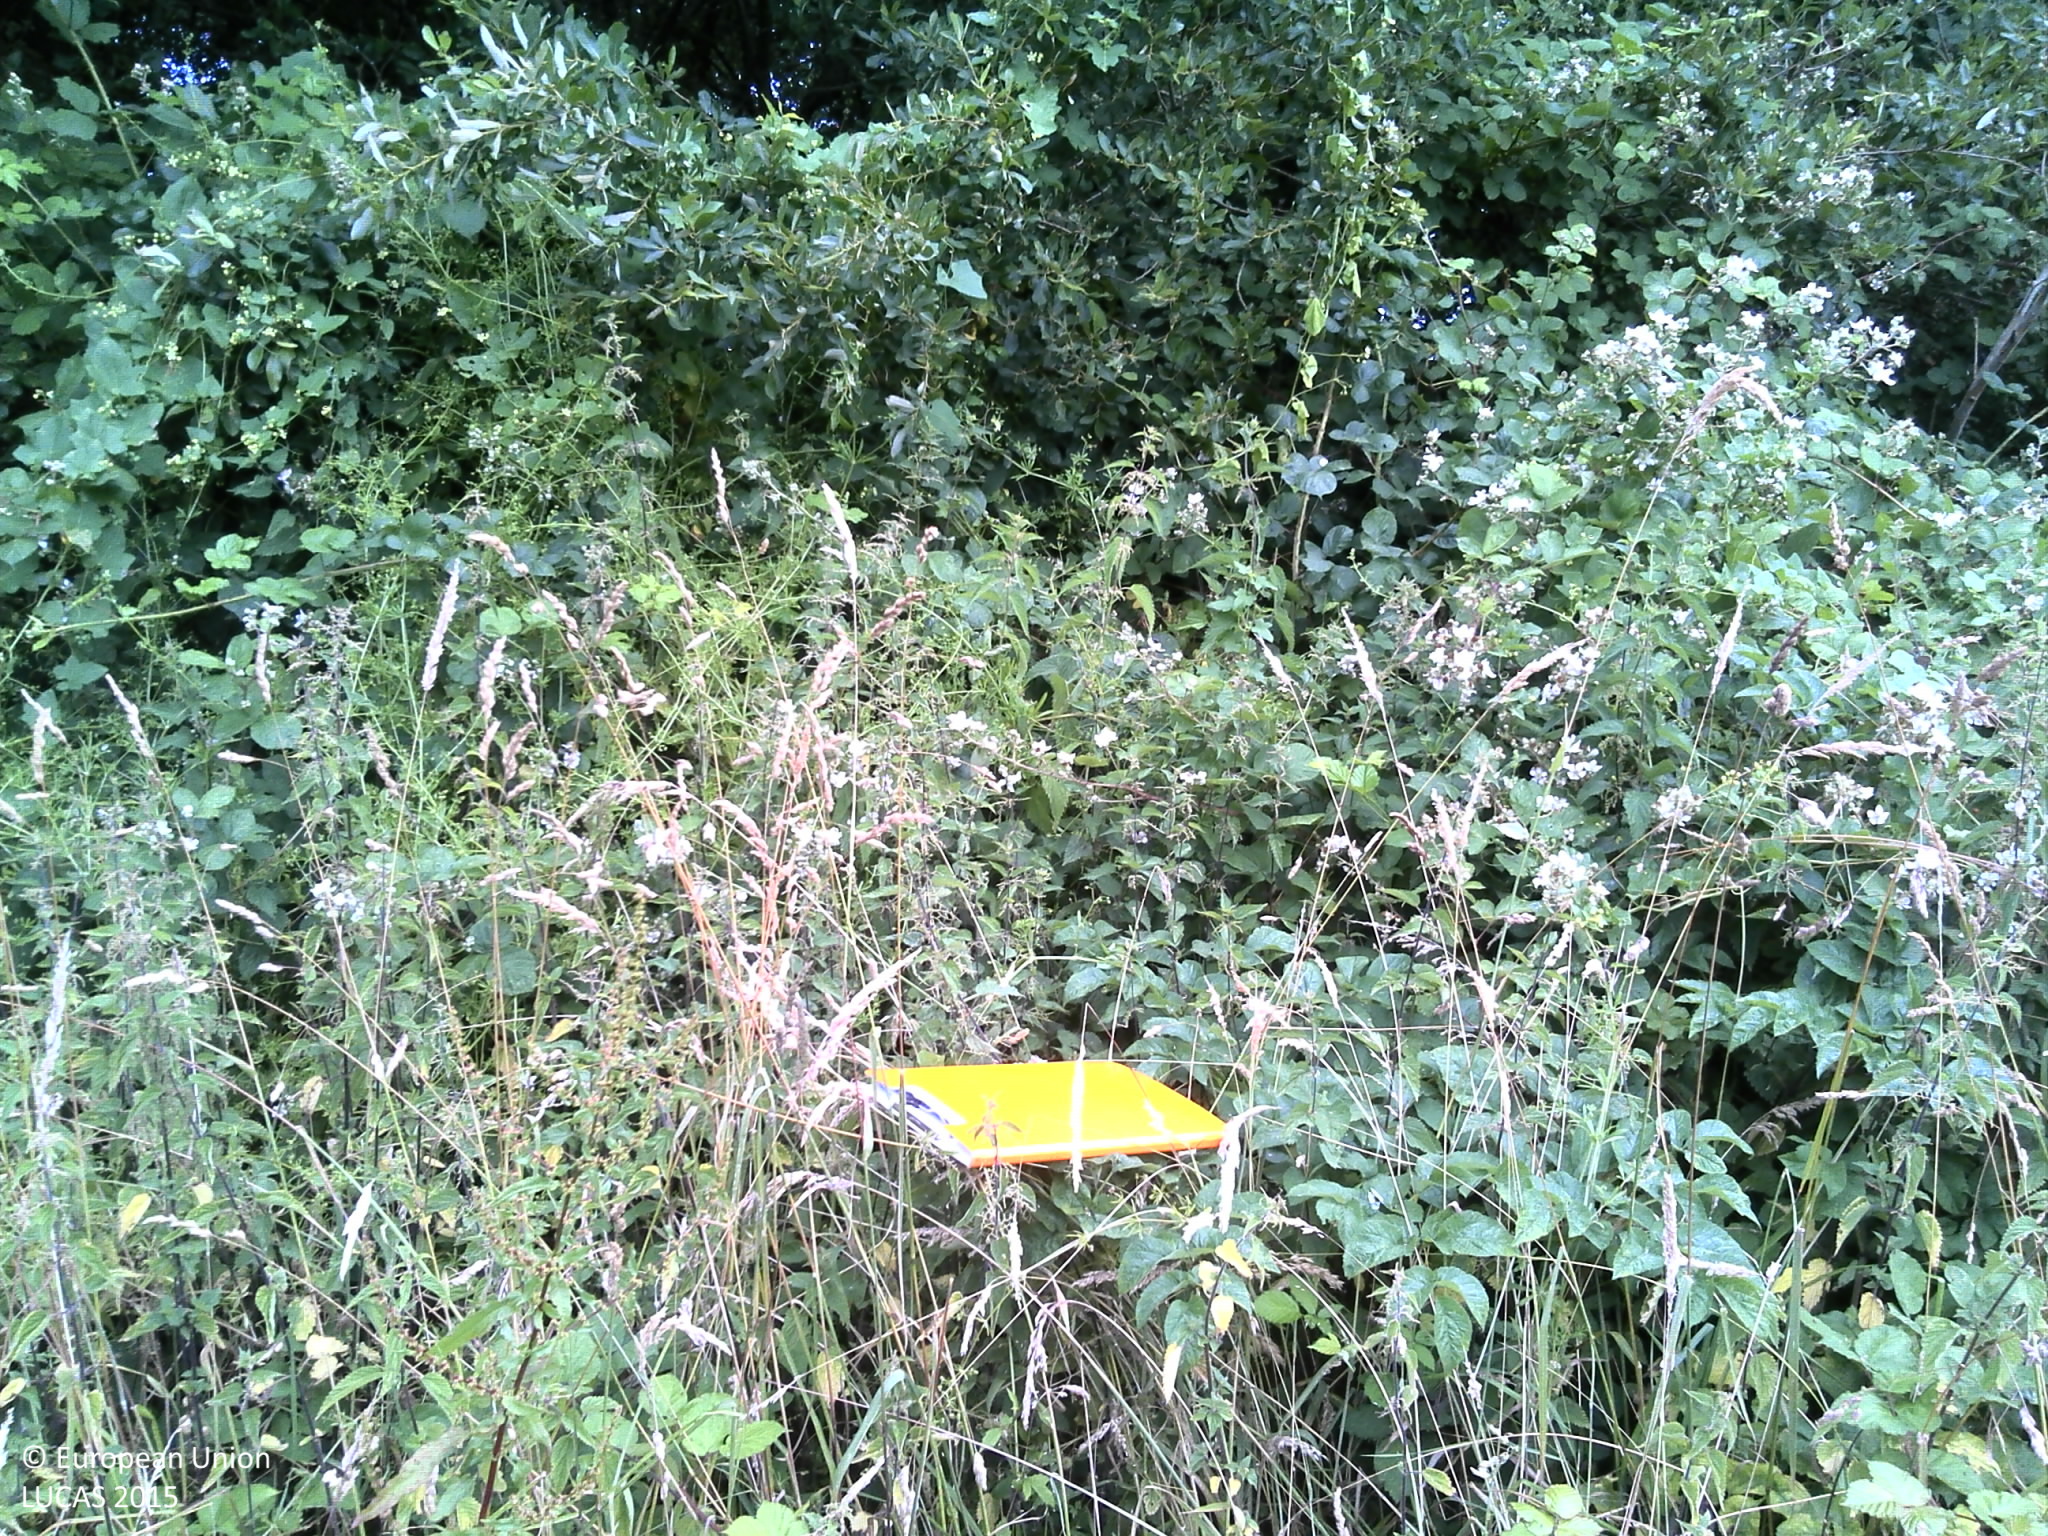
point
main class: Woodland
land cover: Broadleaved woodland
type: acidophilous oak and oak-birch forest
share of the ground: > 75 %
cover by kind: broadleaved forest trees 90 %, shrubs 5 %, herbaceous plants 5 %
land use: Agriculture (excluding fallow land and kitchen gardens)
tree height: > 5 m
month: July
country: FR
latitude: 48.1544
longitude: -4.2197
